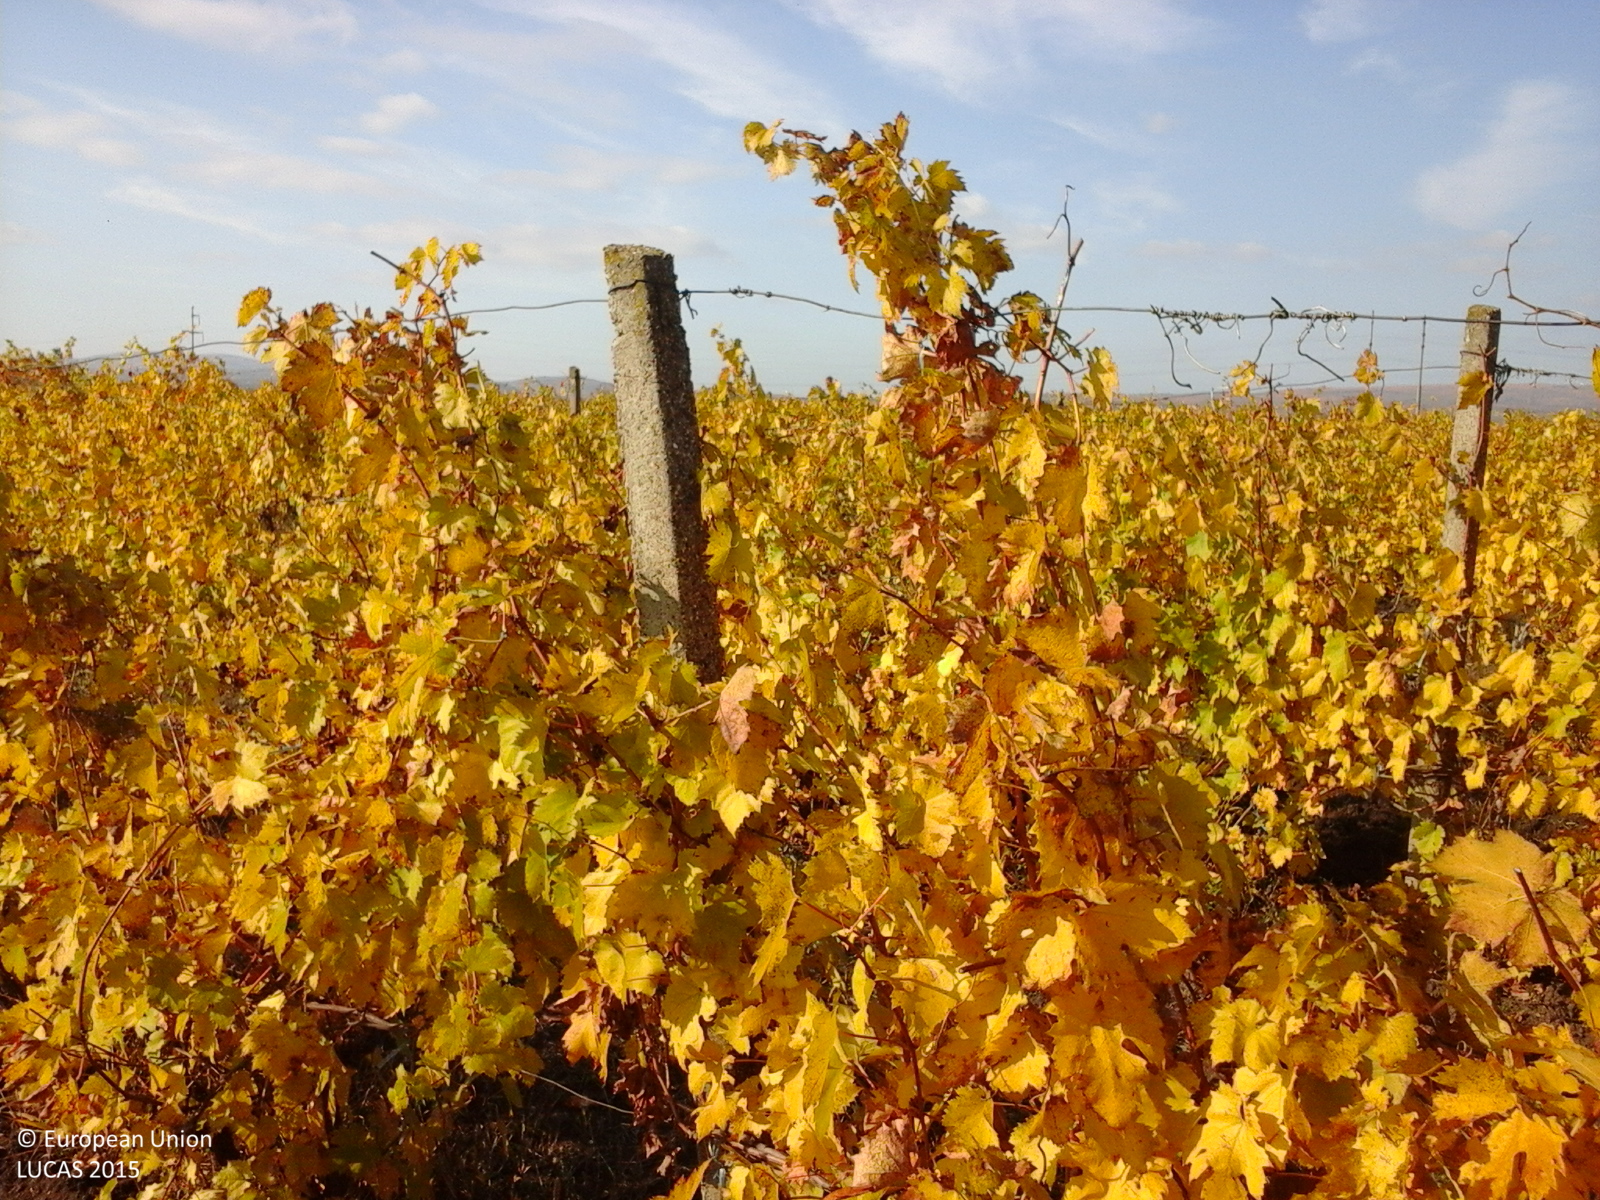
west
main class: Cropland
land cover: Vineyards
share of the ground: > 75 %
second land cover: Other bare soil
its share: > 75 %
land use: Agriculture (excluding fallow land and kitchen gardens)
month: October
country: RO
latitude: 45.5824
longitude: 27.1251
